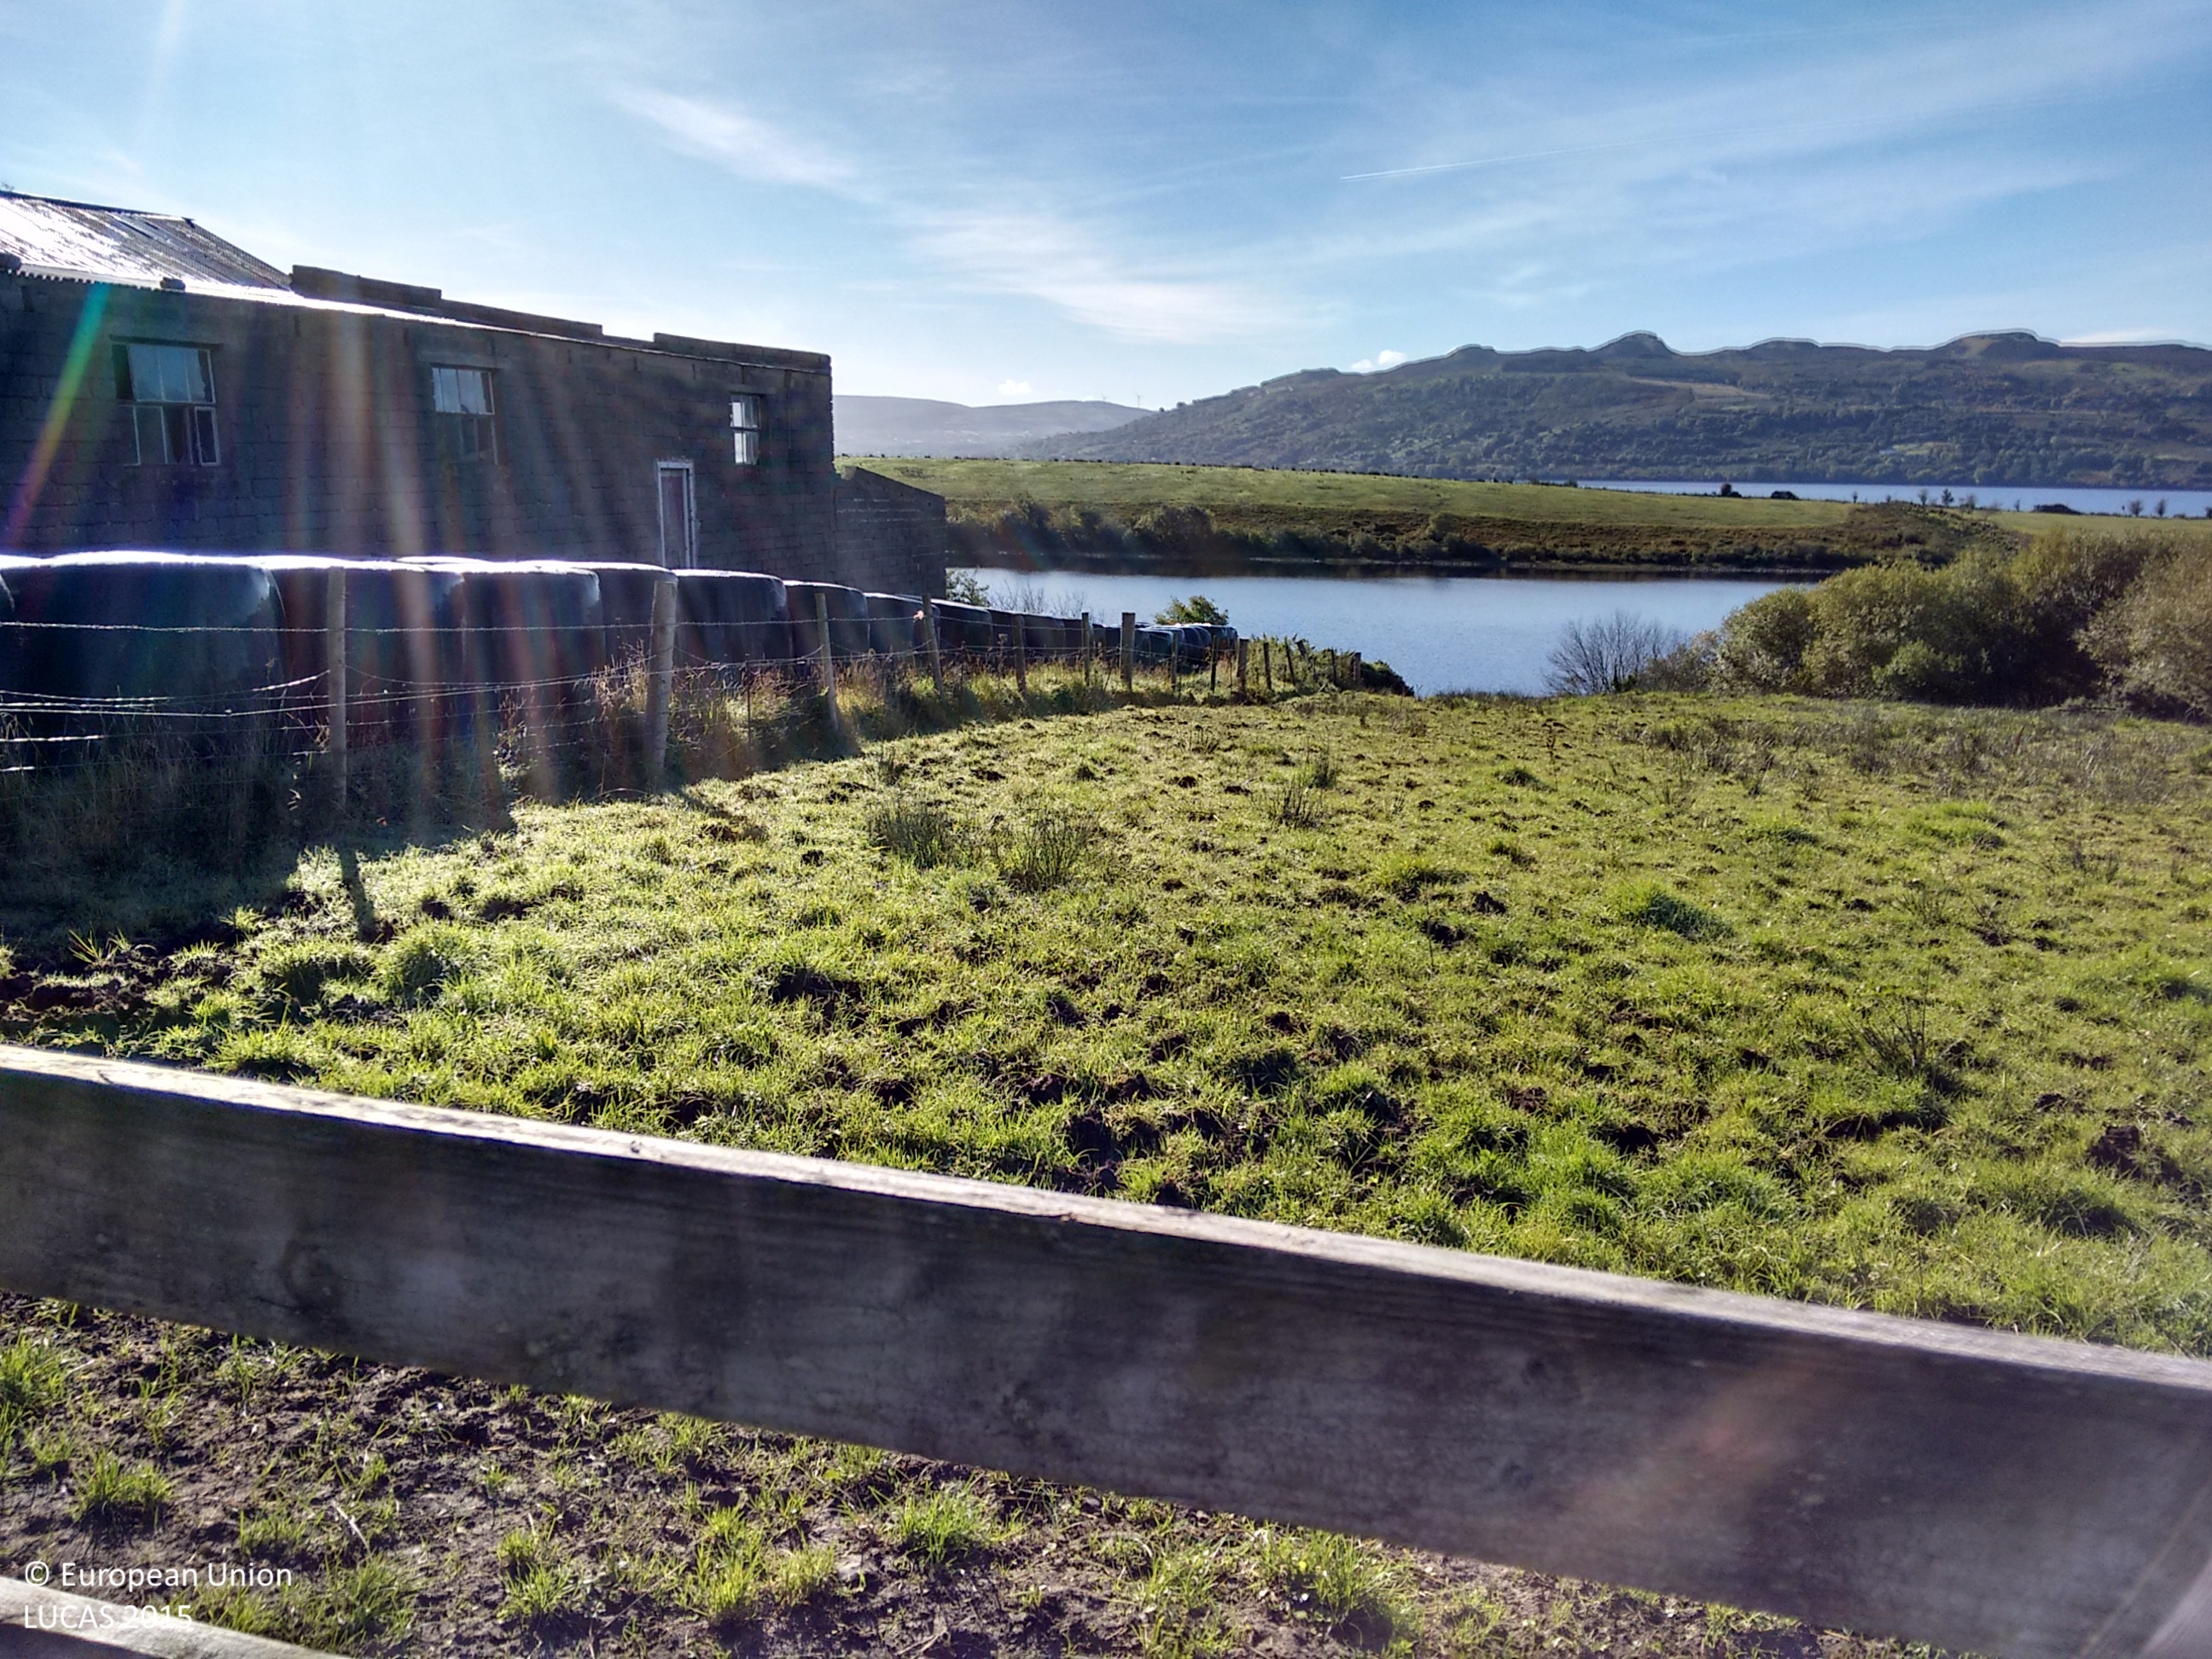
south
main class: Grassland
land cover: Grassland without tree/shrub cover
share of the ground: > 75 %
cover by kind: herbaceous plants 100 %
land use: Agriculture (excluding fallow land and kitchen gardens)
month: October
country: GB
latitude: 54.4341
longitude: -8.1384
